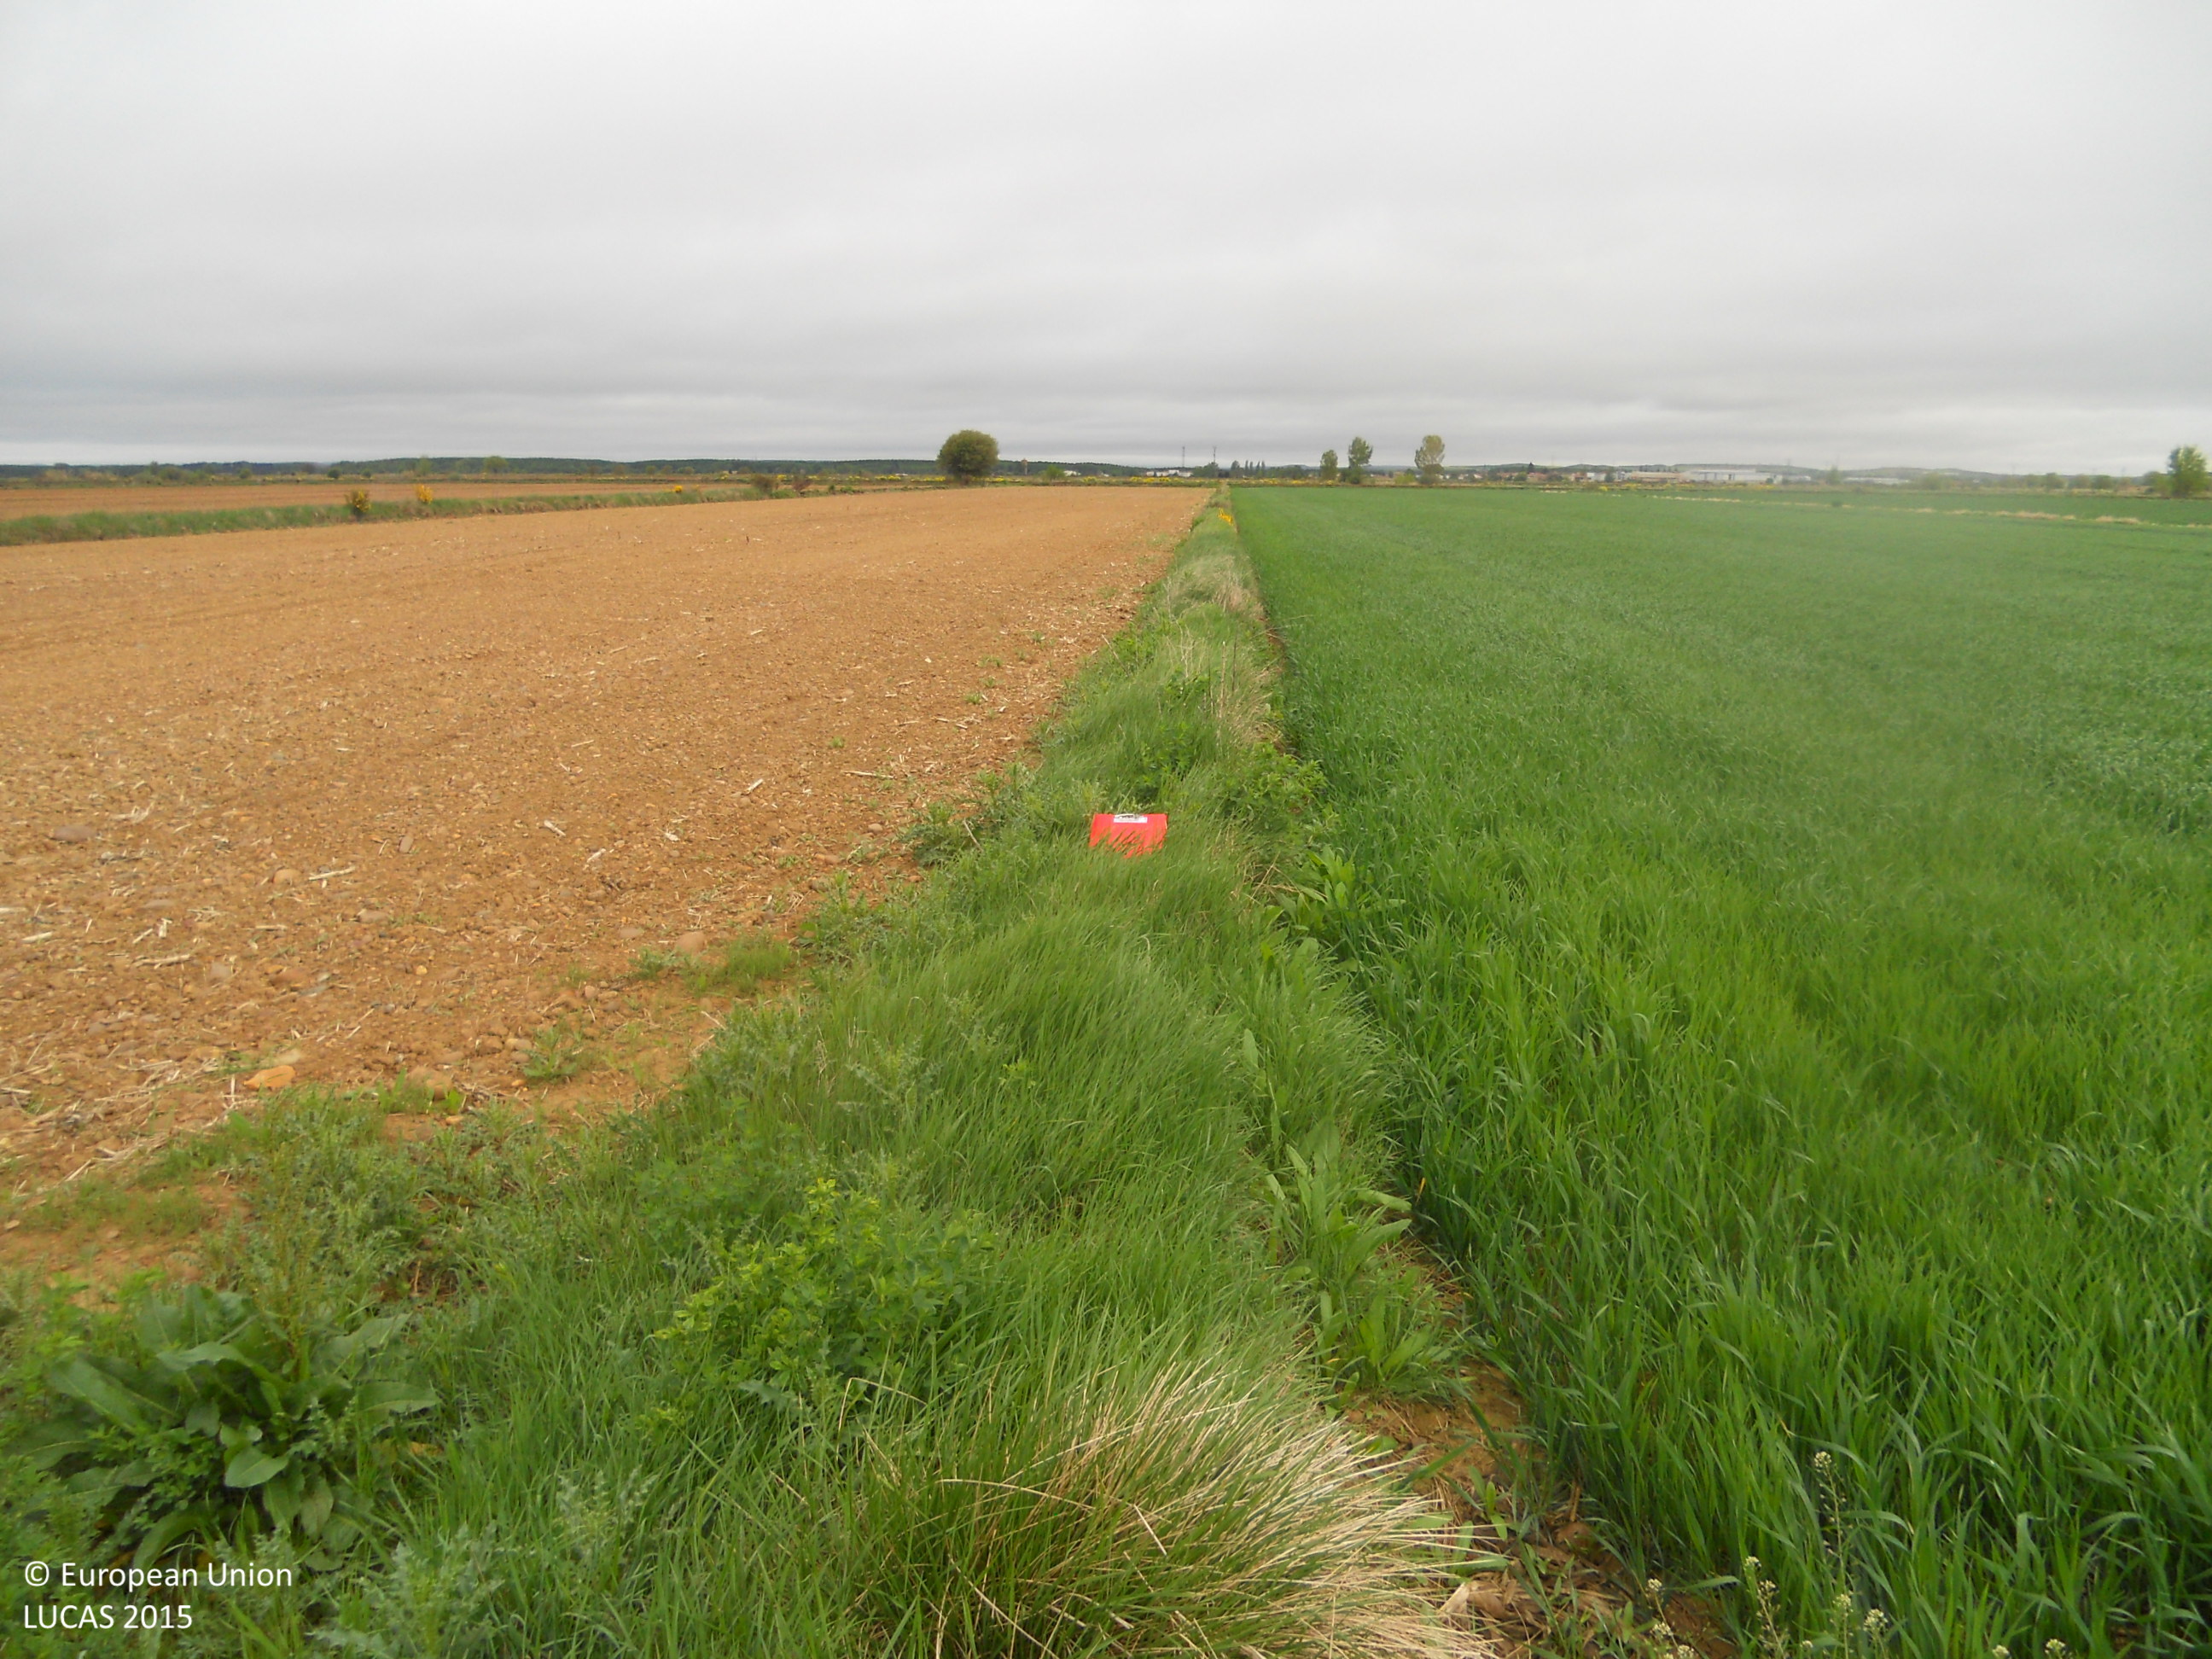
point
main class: Cropland
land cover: Common wheat
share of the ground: > 75 %
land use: Agriculture (excluding fallow land and kitchen gardens)
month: May
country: ES
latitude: 42.4763
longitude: -5.4067
